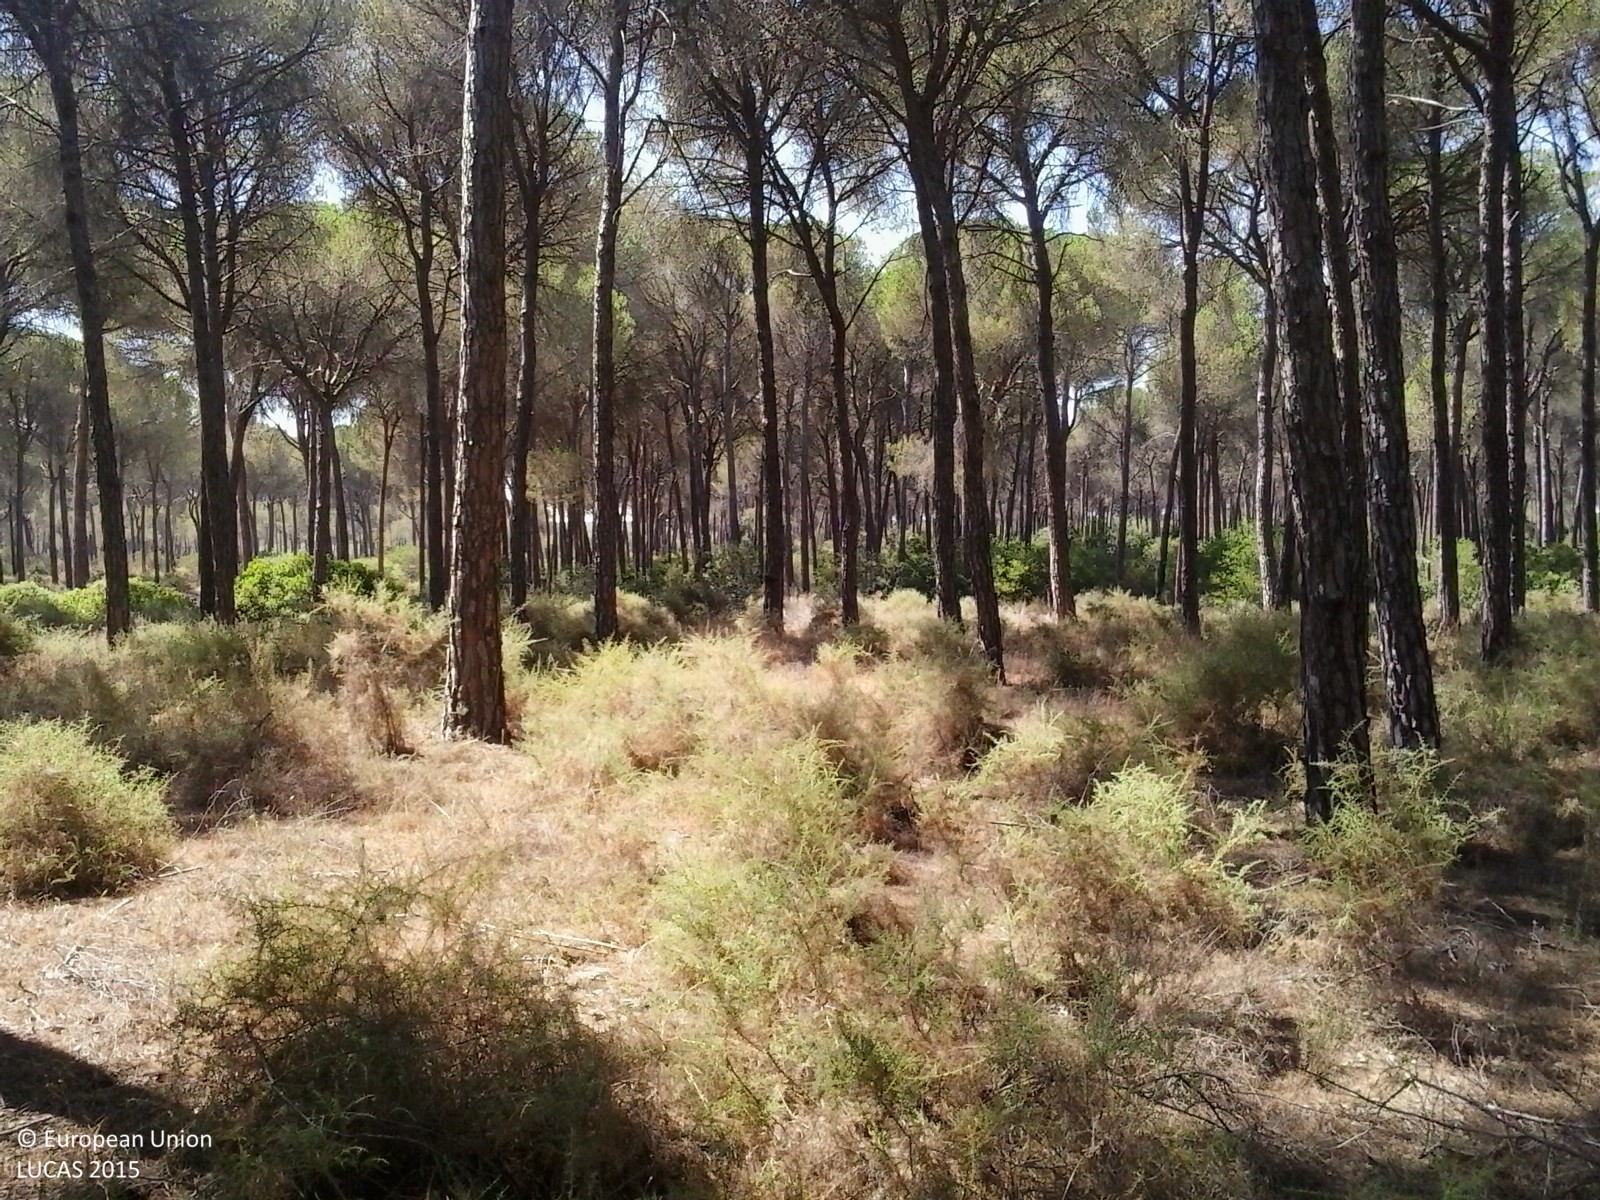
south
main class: Woodland
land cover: Pine dominated coniferous woodland
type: coniferous forest of the mediterranean region
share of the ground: > 75 %
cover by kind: coniferous forest trees 75 %, herbaceous plants 15 %, shrubs 10 %
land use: Forestry
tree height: > 5 m
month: July
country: ES
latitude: 37.2388
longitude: -6.3836
